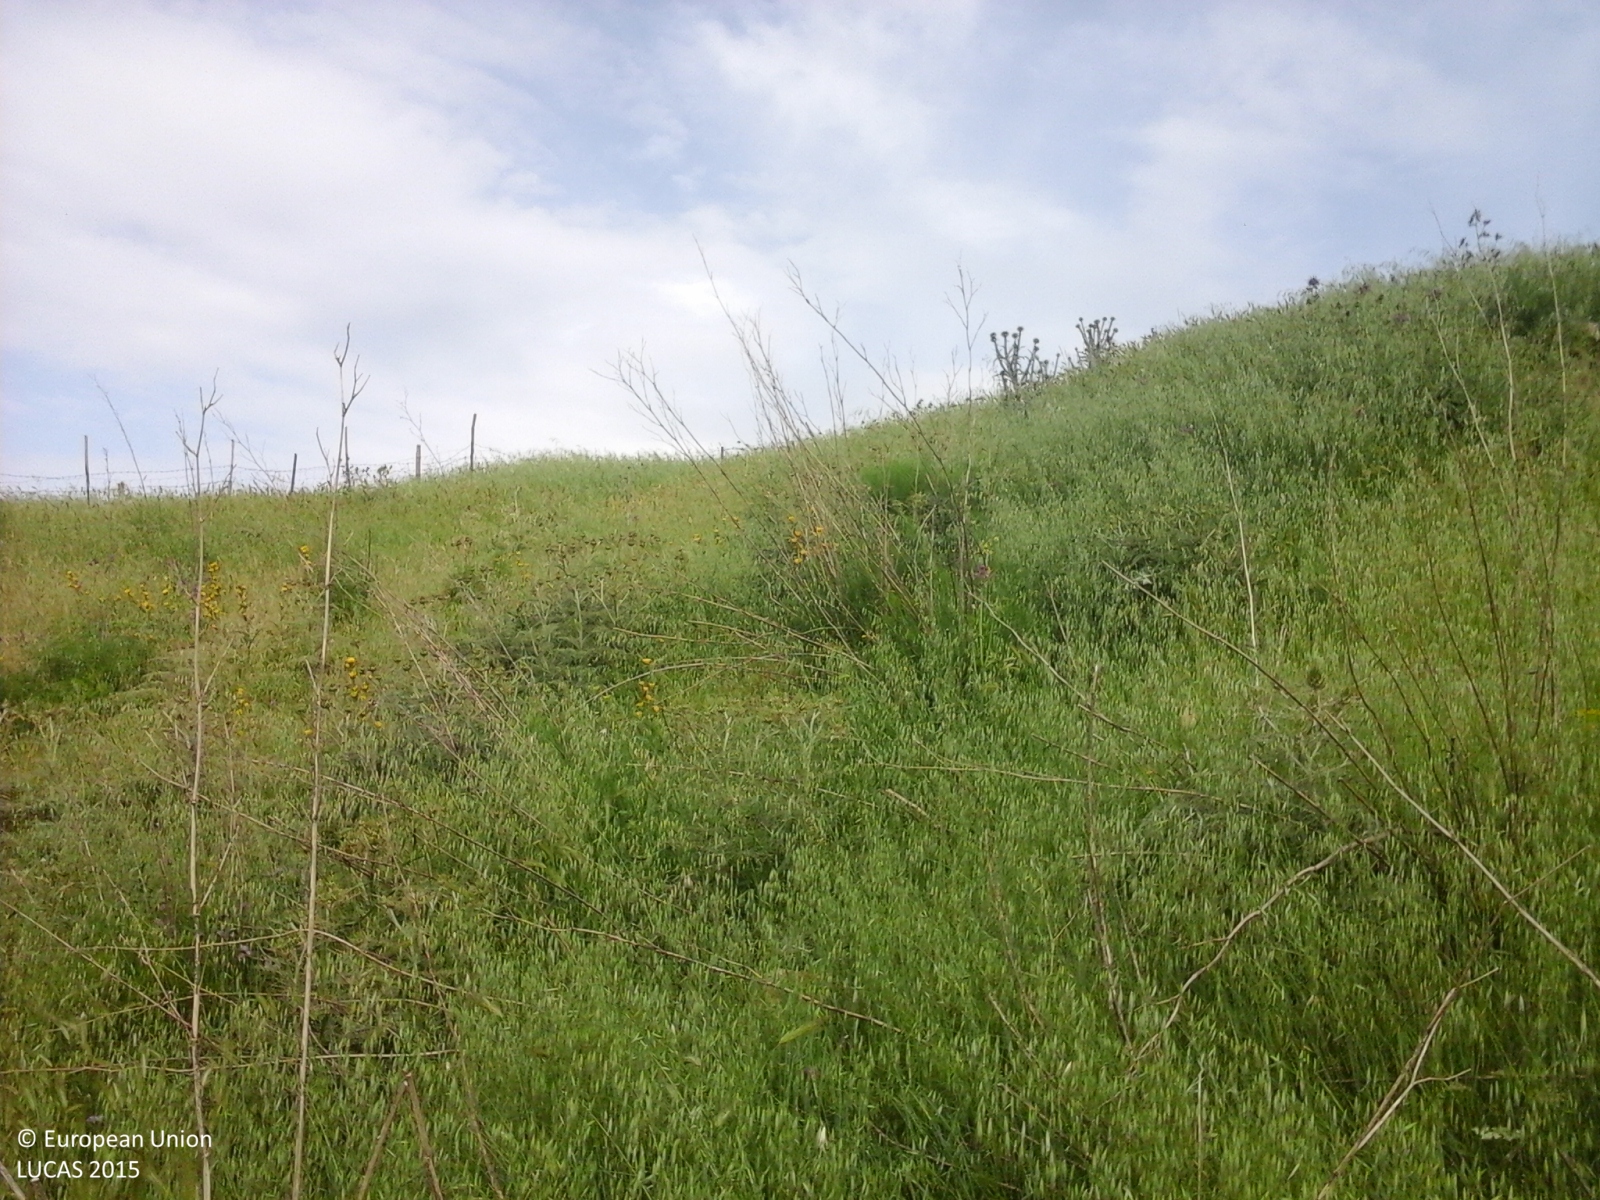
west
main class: Grassland
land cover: Grassland without tree/shrub cover
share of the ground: > 75 %
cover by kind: herbaceous plants 95 %, unconsolidated bare surface 5 %
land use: Agriculture (excluding fallow land and kitchen gardens)
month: May
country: IT
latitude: 37.7017
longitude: 13.9523
